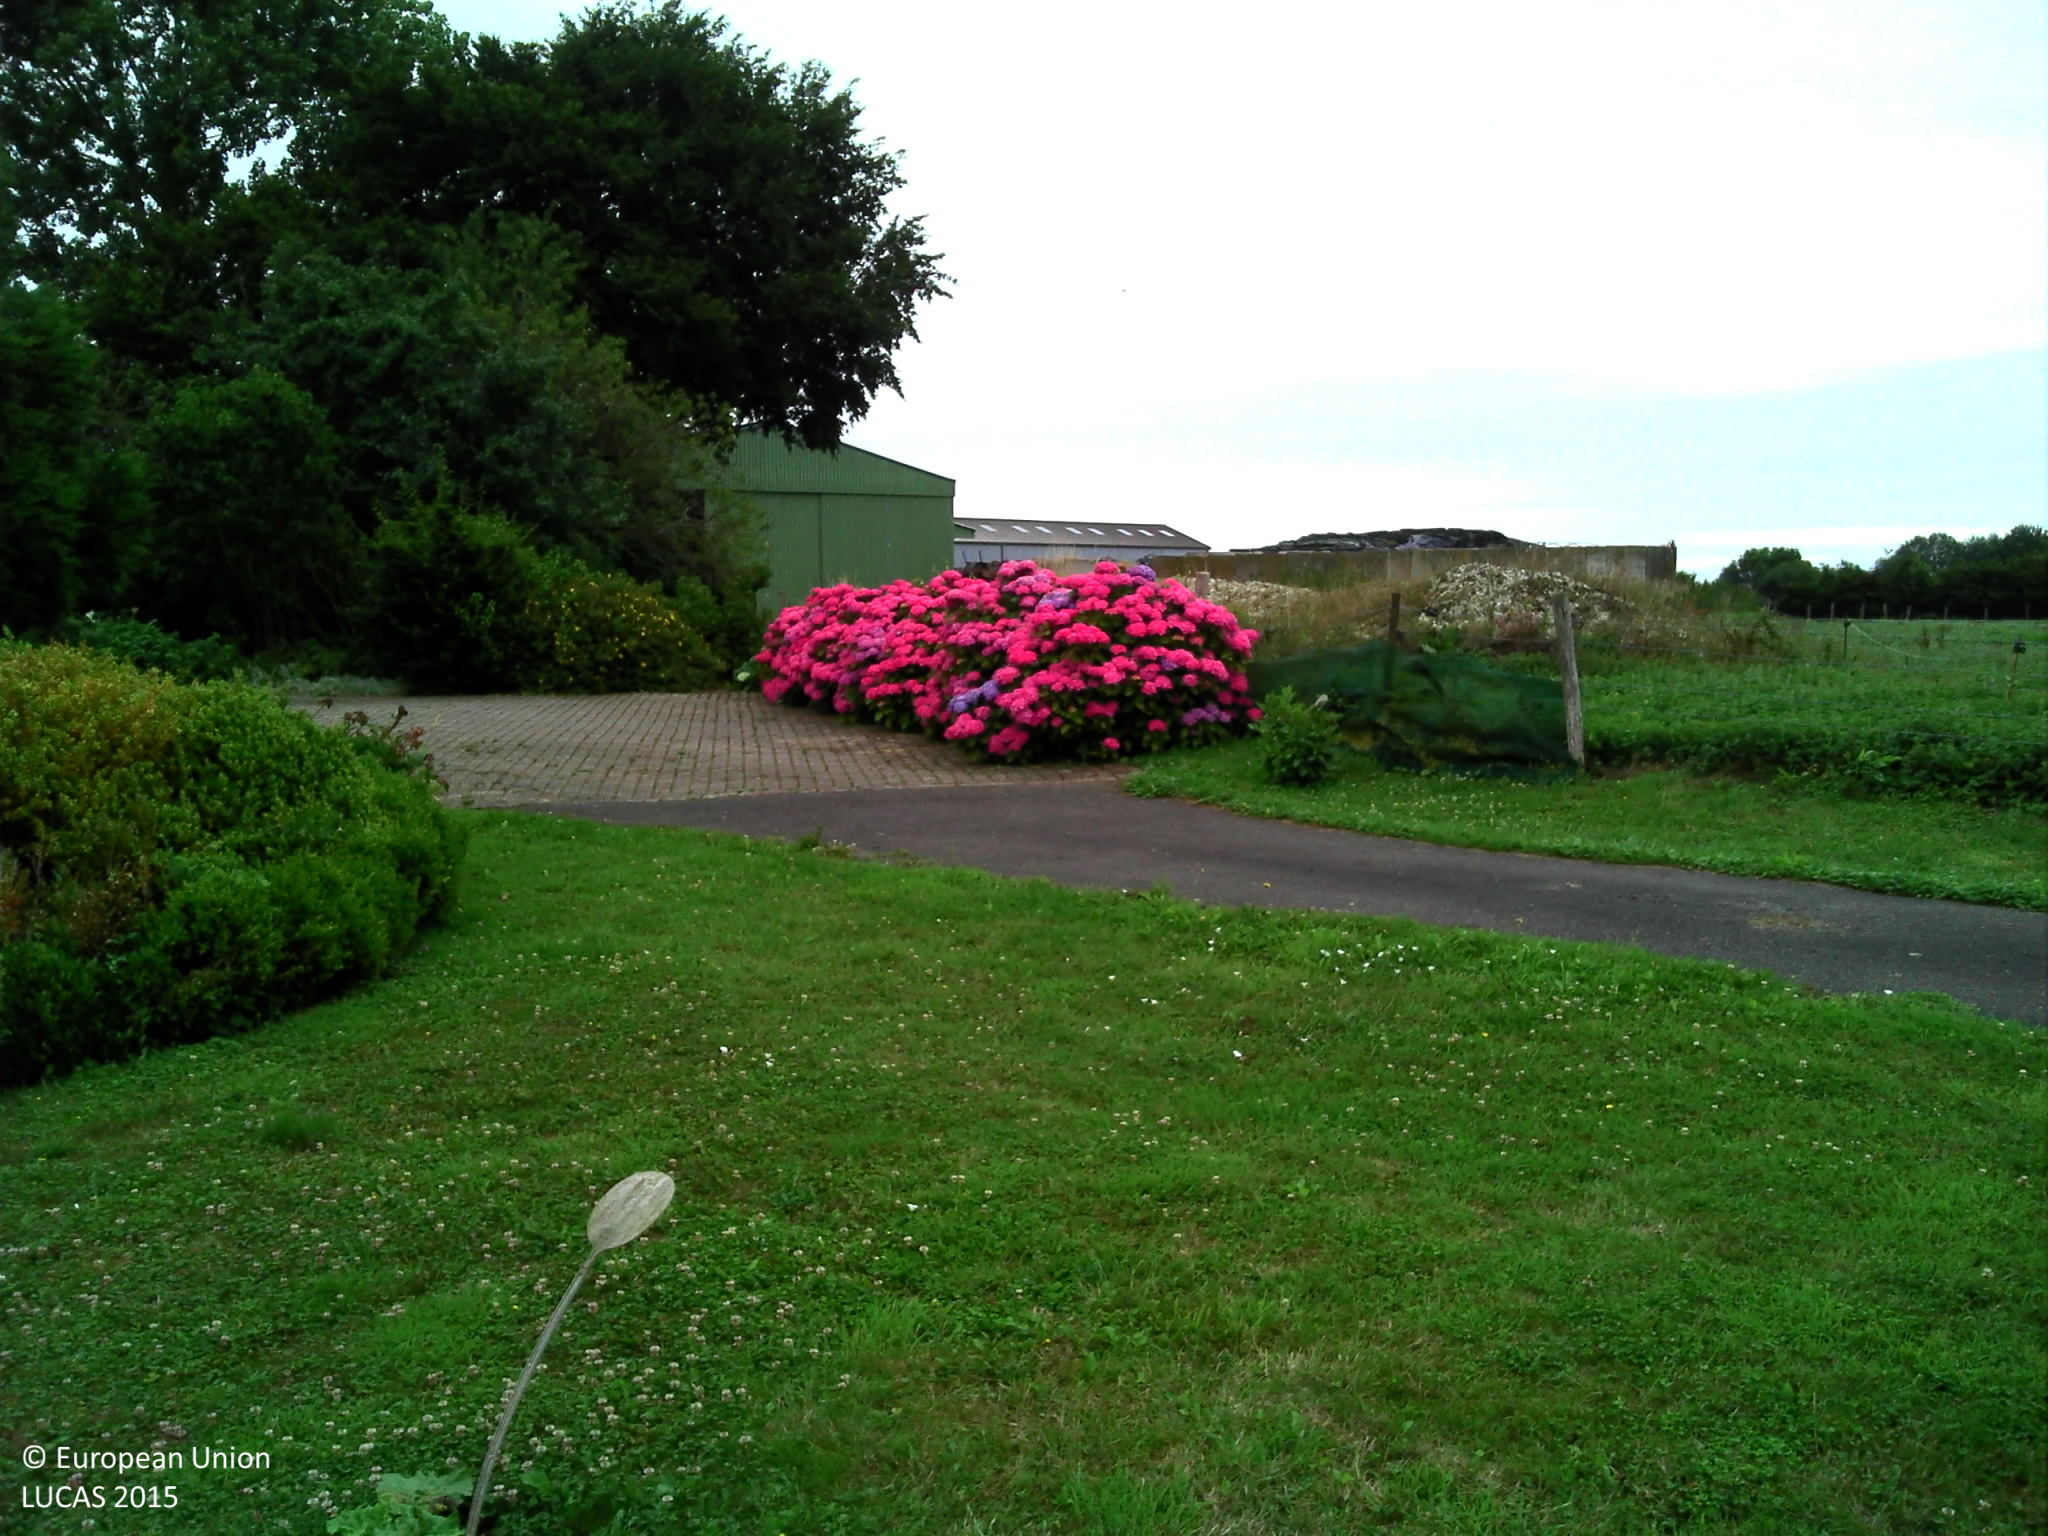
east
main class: Grassland
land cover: Grassland without tree/shrub cover
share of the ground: > 75 %
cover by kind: herbaceous plants 95 %
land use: Residential
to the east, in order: Fences; Grassland without tree/shrub cover; Artificial constructions in urban areas; Grassland without tree/shrub cover; Artificial constructions in urban areas; Grassland without tree/shrub cover
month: July
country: FR
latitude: 50.1895
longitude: 2.4940
